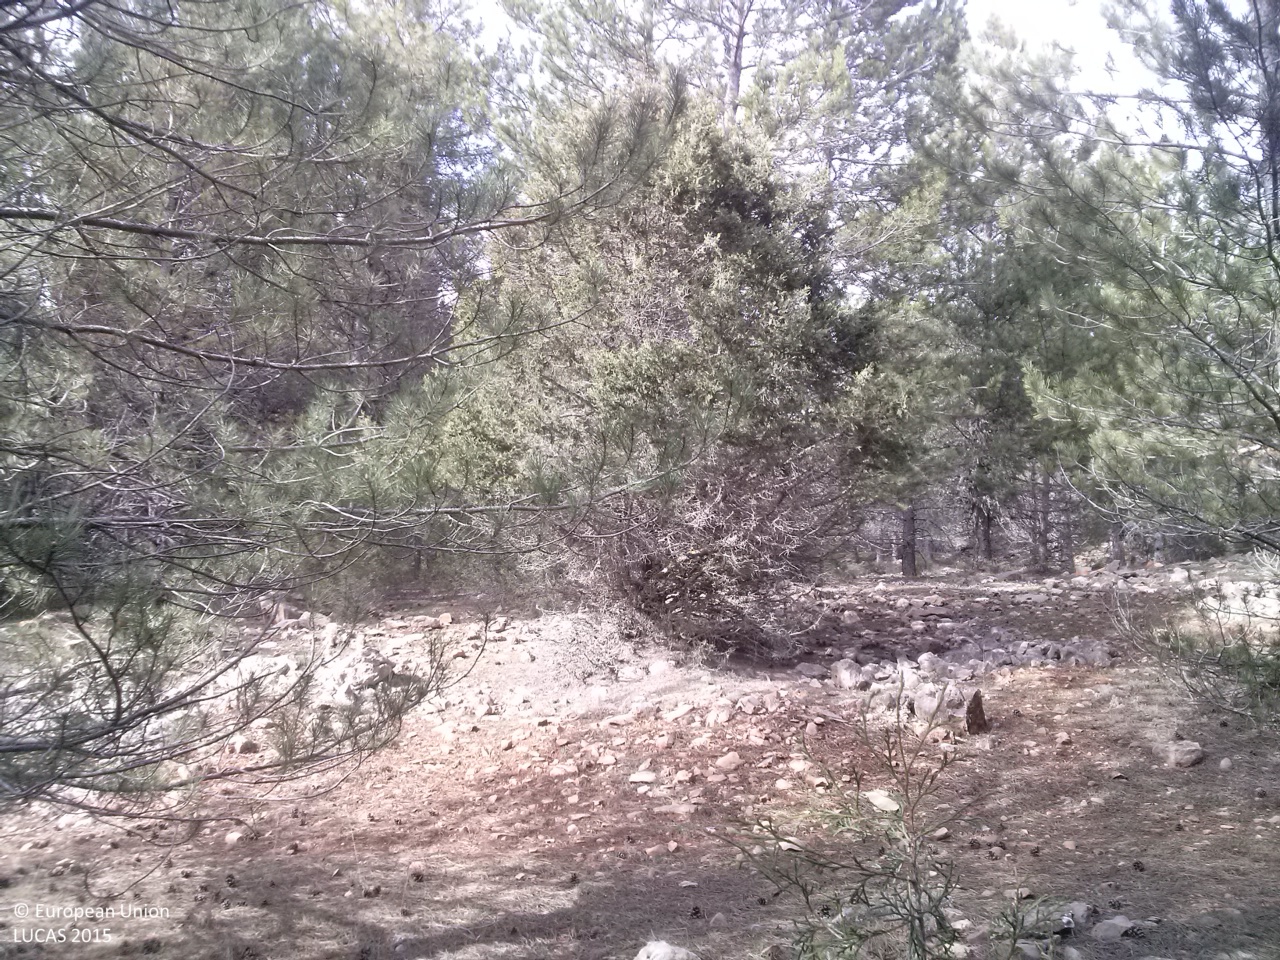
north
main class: Woodland
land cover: Pine dominated coniferous woodland
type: coniferous forest of the mediterranean region
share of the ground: 50 - 75 %
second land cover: Grassland without tree/shrub cover
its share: 10 - 25 %
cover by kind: coniferous forest trees 70 %, herbaceous plants 25 %, shrubs 5 %
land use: Forestry
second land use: Agriculture (excluding fallow land and kitchen gardens)
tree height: > 5 m
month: April
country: ES
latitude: 40.0918
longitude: -1.8717
